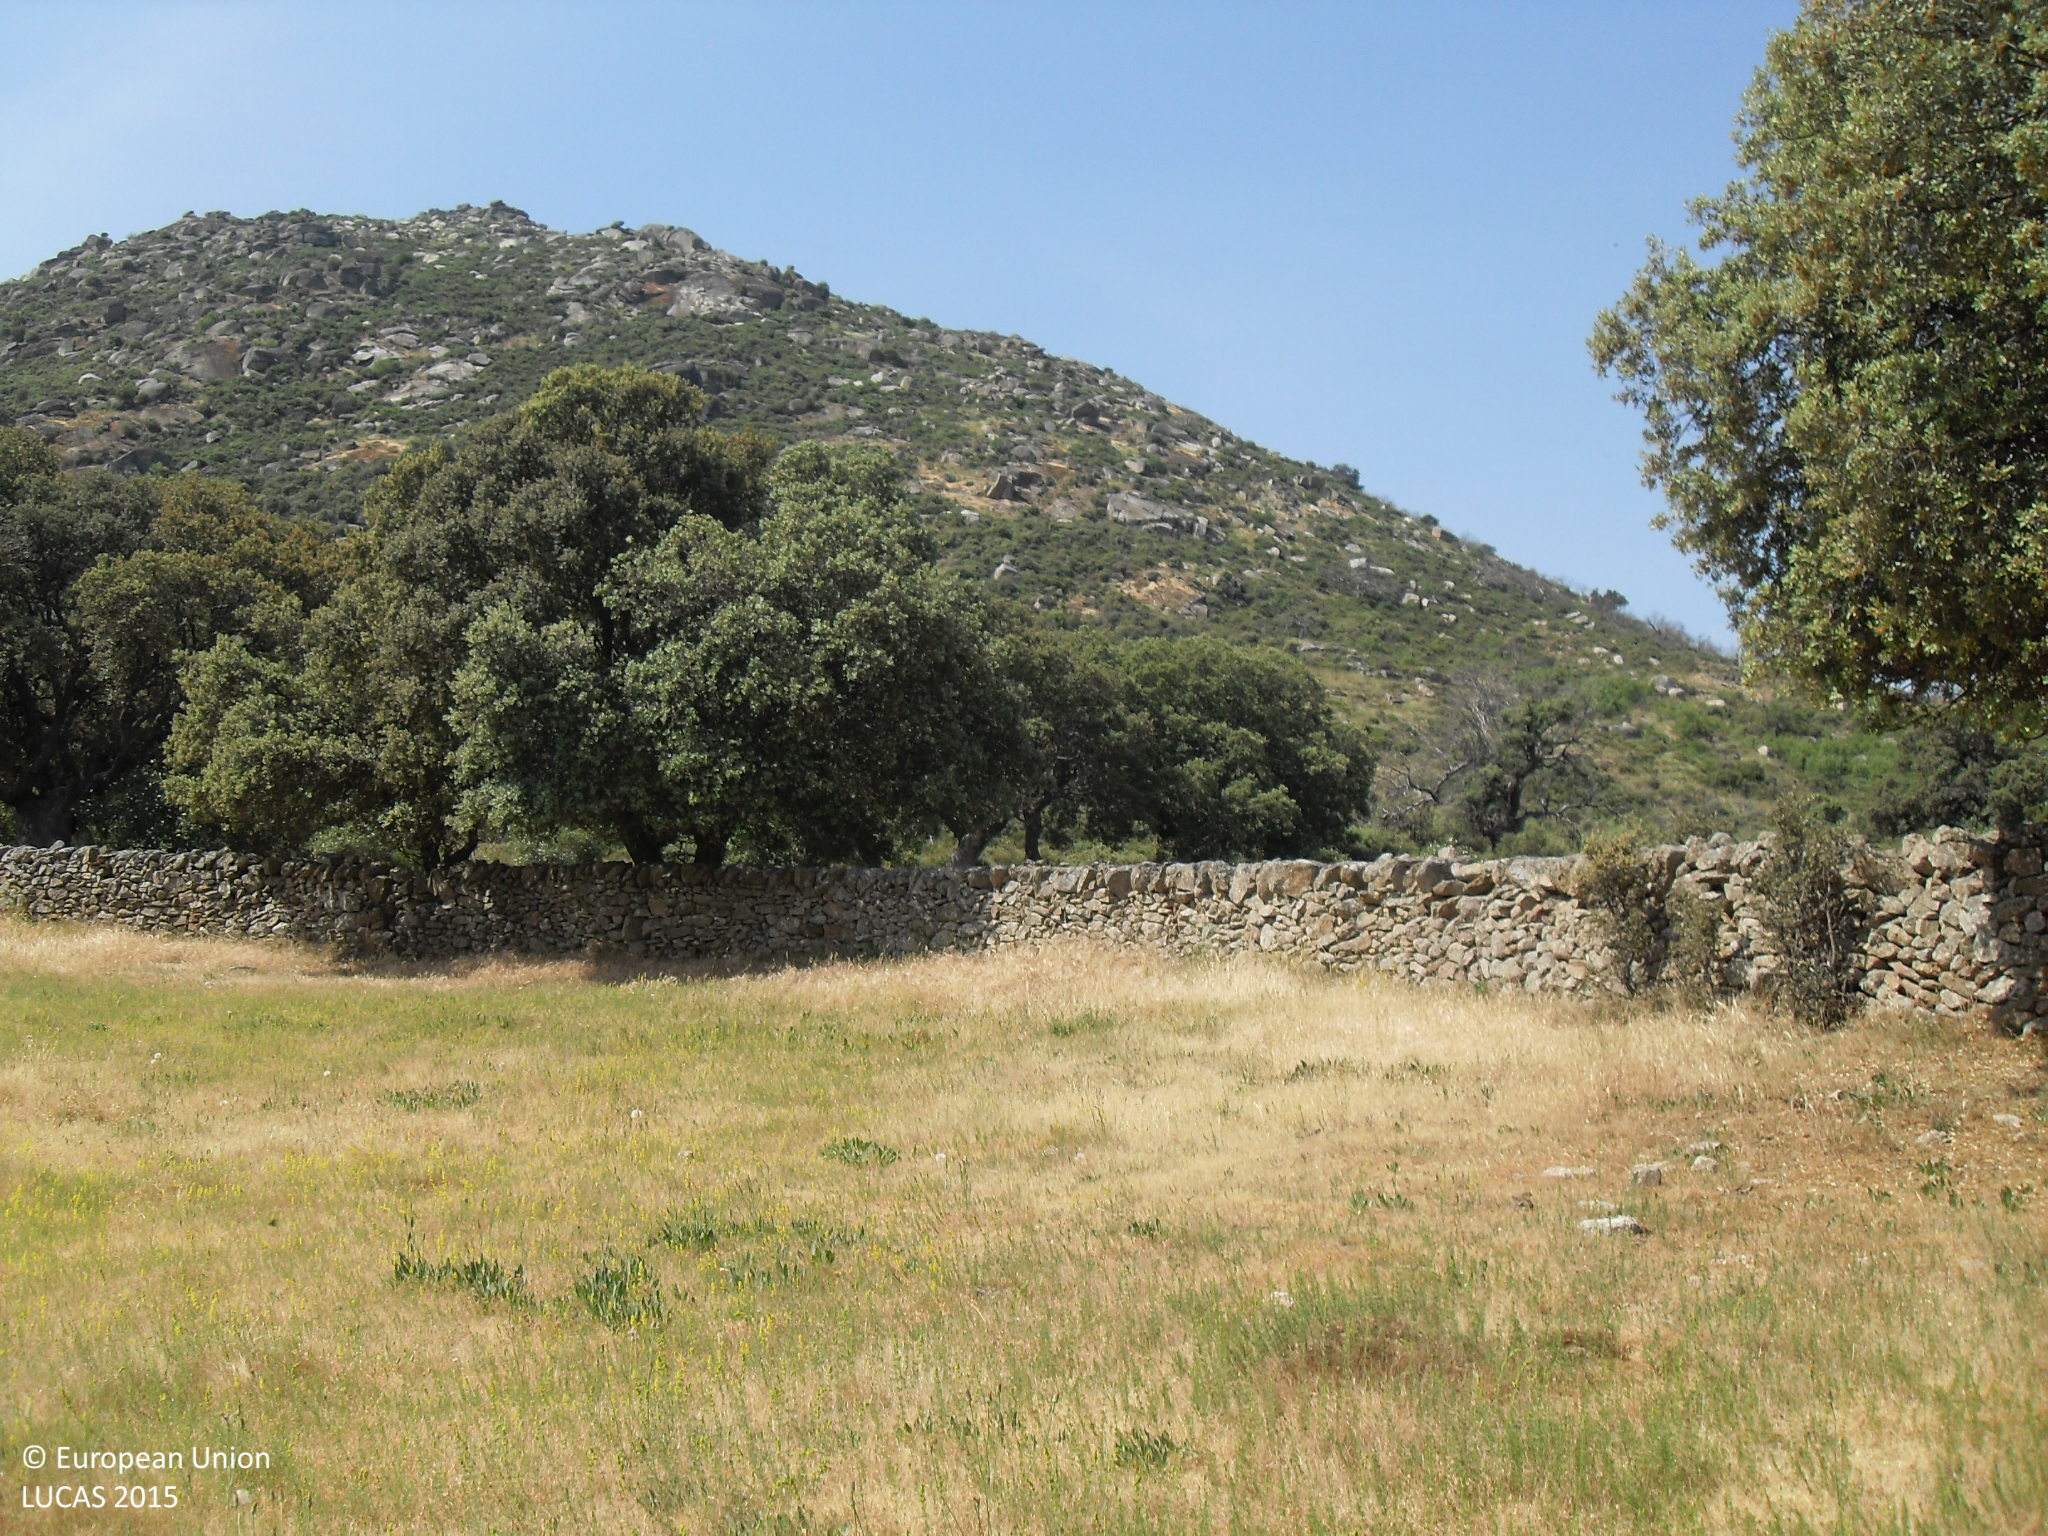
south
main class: Grassland
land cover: Grassland with sparse tree/shrub cover
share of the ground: > 75 %
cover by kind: herbaceous plants 95 %, broadleaved forest trees 5 %
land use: Agriculture (excluding fallow land and kitchen gardens)
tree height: < 5 m
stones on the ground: < 10 %
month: June
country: ES
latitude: 40.4704
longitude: -5.5542
